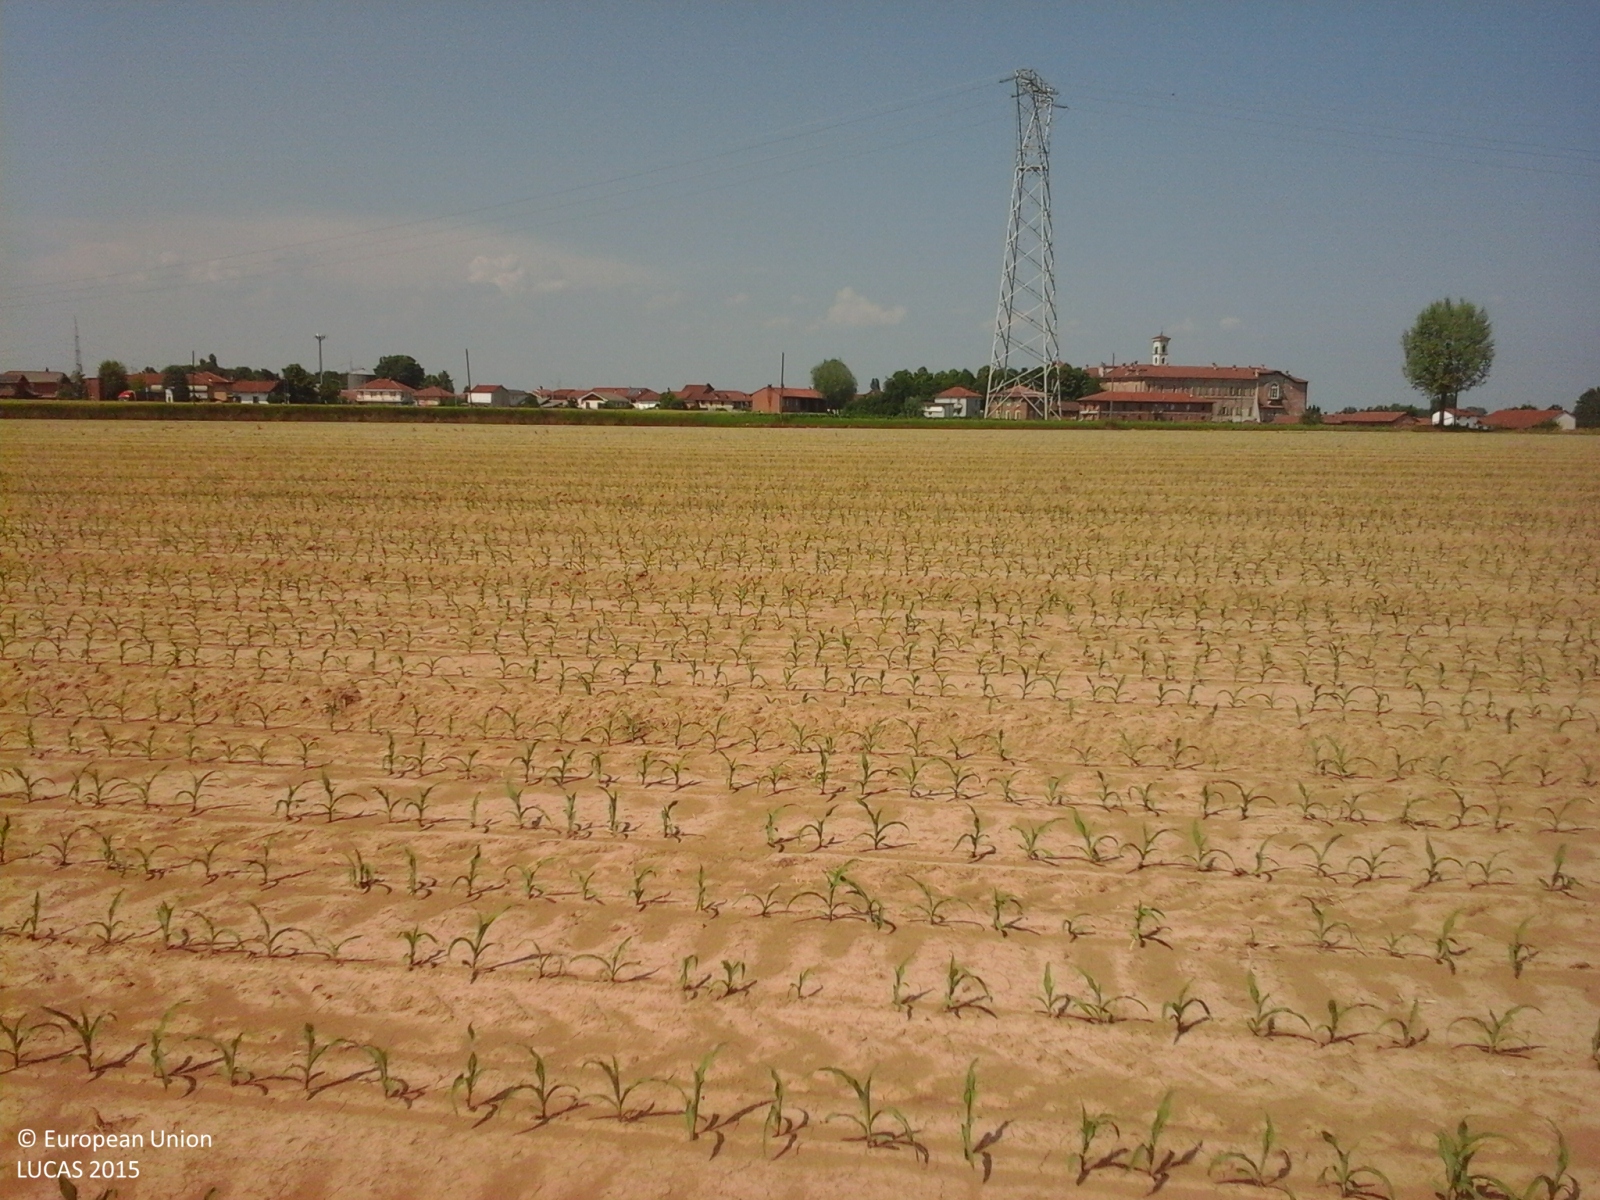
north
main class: Cropland
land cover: Maize
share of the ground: < 10 %
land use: Agriculture (excluding fallow land and kitchen gardens)
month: June
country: IT
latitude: 44.8682
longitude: 7.7892
